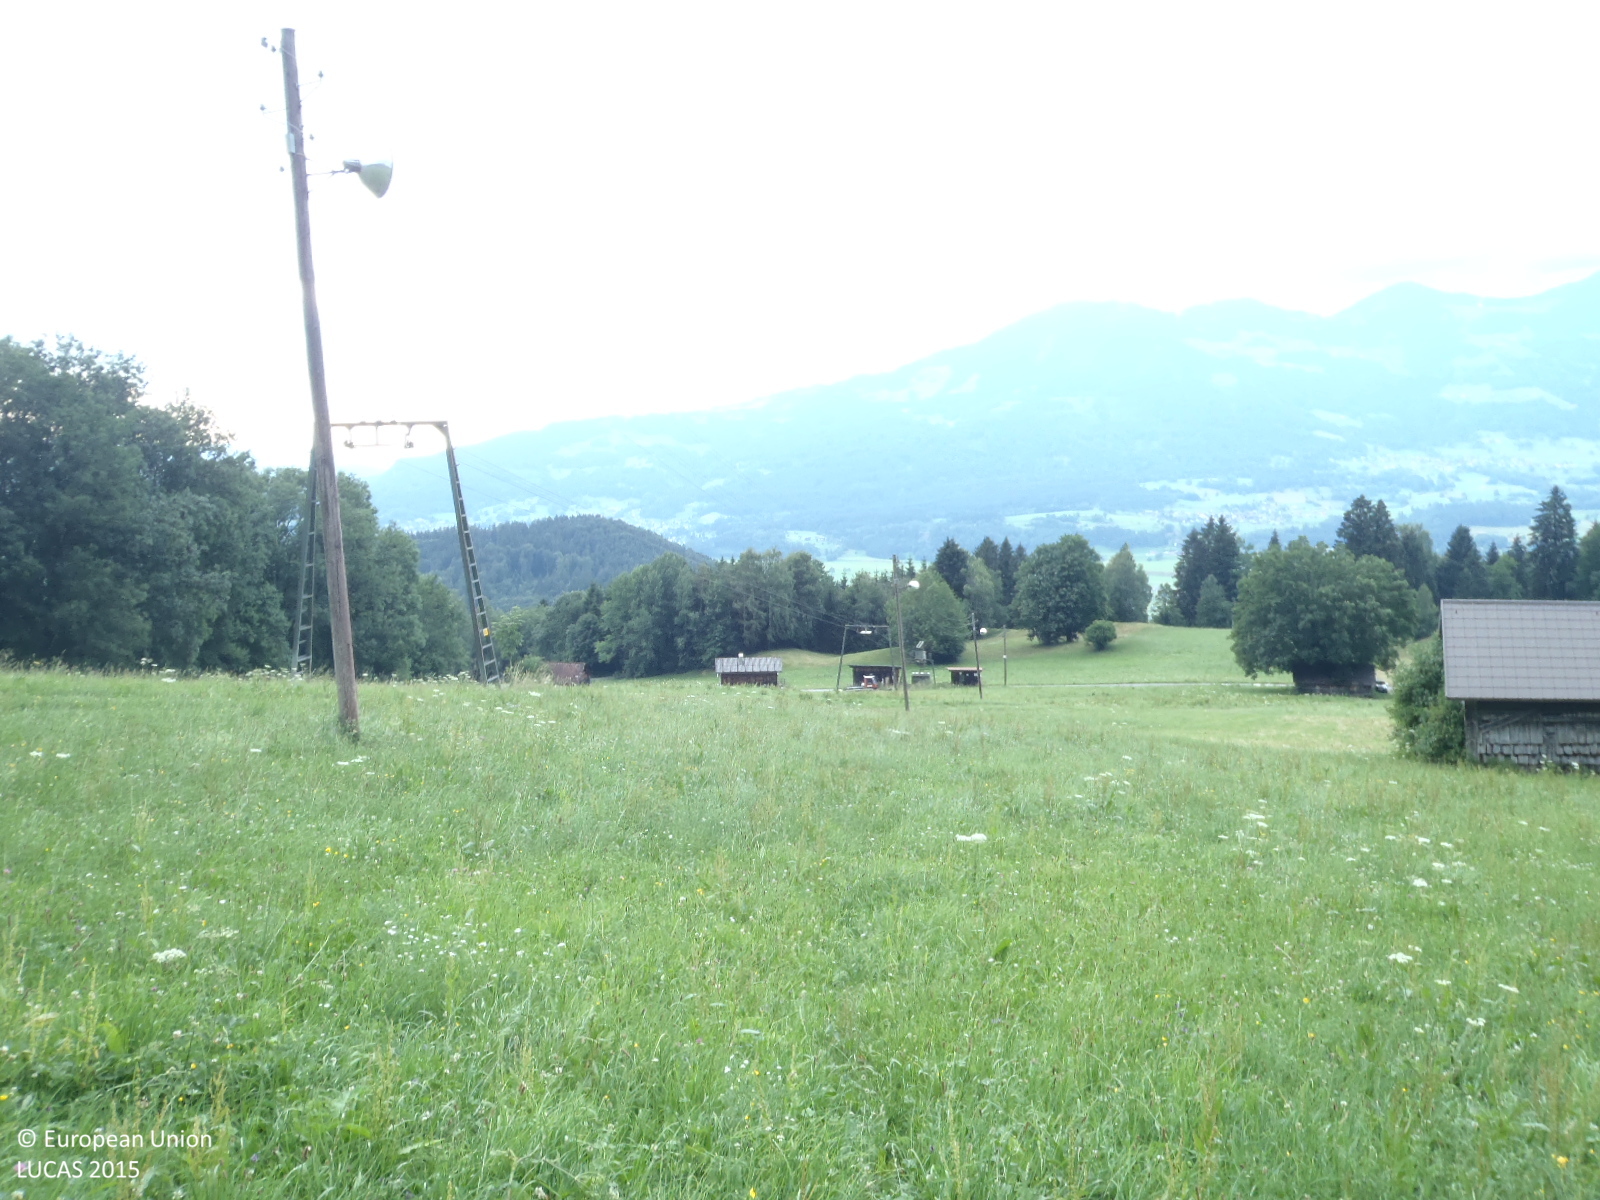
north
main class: Grassland
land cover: Grassland without tree/shrub cover
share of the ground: > 75 %
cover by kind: herbaceous plants 100 %
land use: Agriculture (excluding fallow land and kitchen gardens)
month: July
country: AT
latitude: 47.1791
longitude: 9.6705
